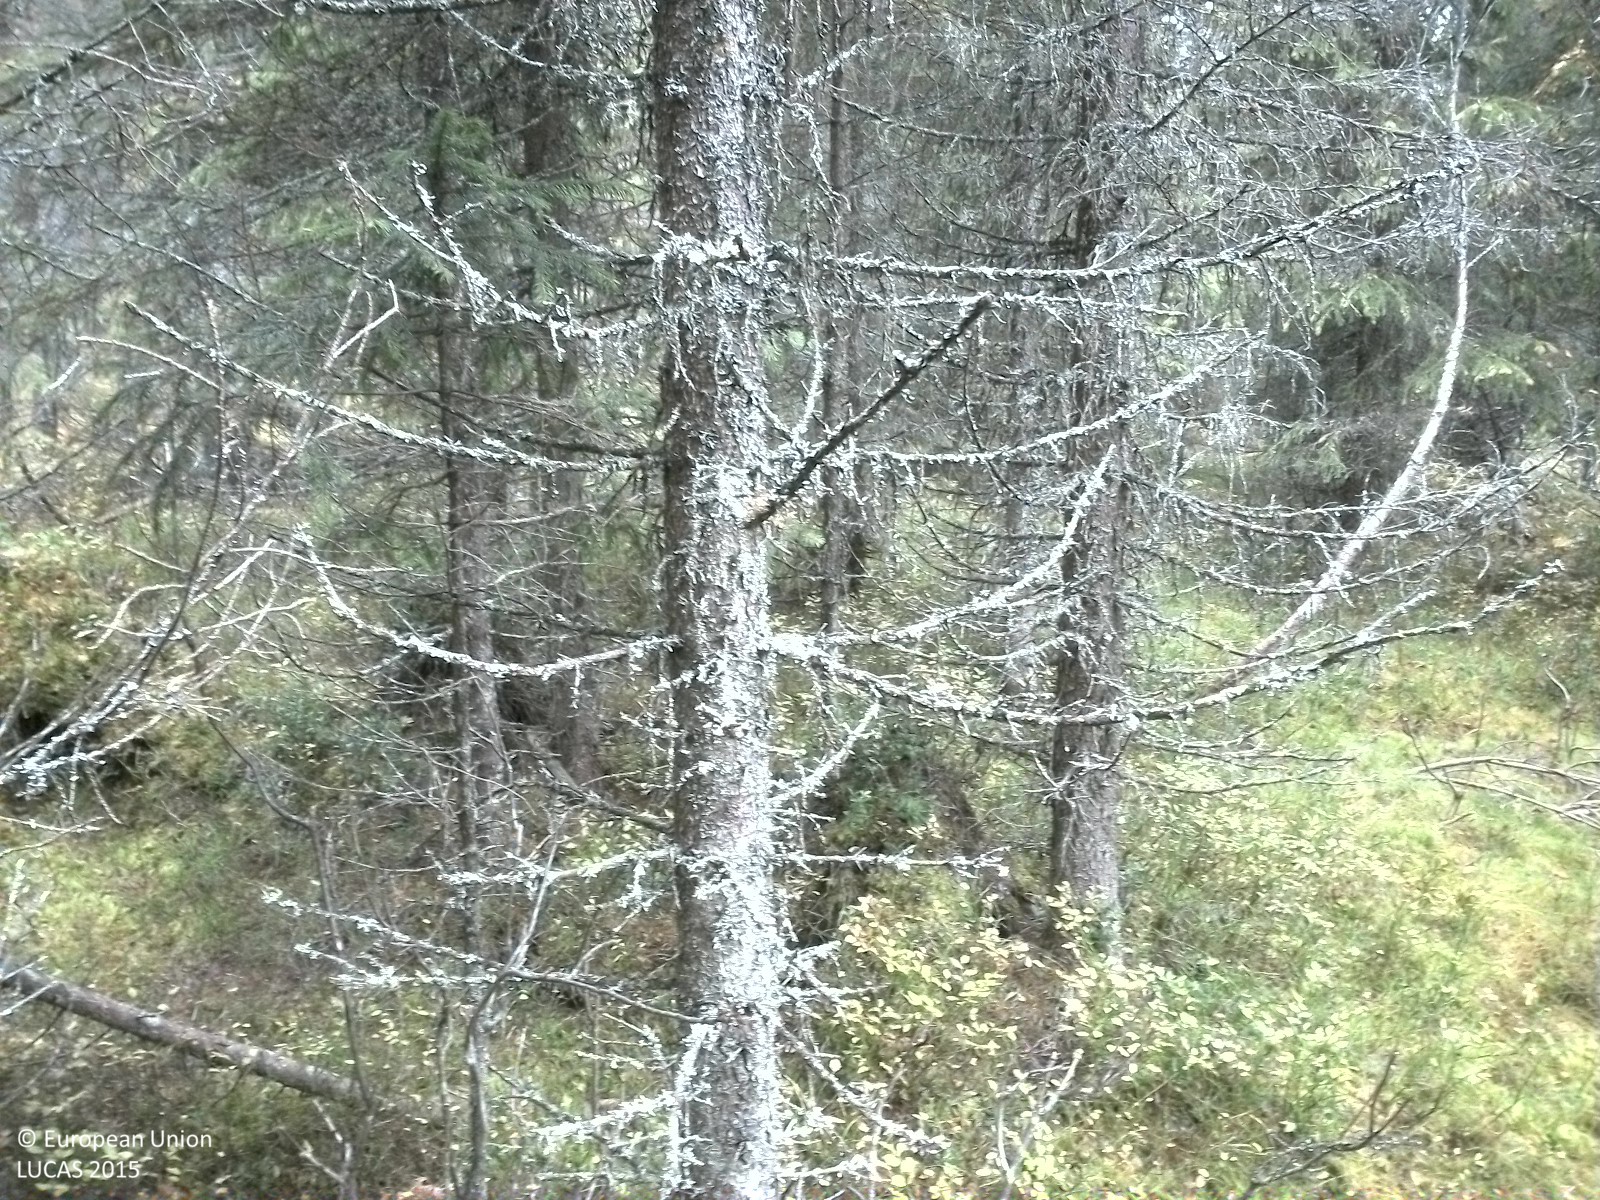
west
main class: Woodland
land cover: Spruce dominated mixed woodland
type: boreal forest
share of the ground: > 75 %
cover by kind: coniferous forest trees 60 %, broadleaved forest trees 20 %, shrubs 20 %
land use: Forestry
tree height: > 5 m
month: October
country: SE
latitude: 63.5960
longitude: 14.9946
